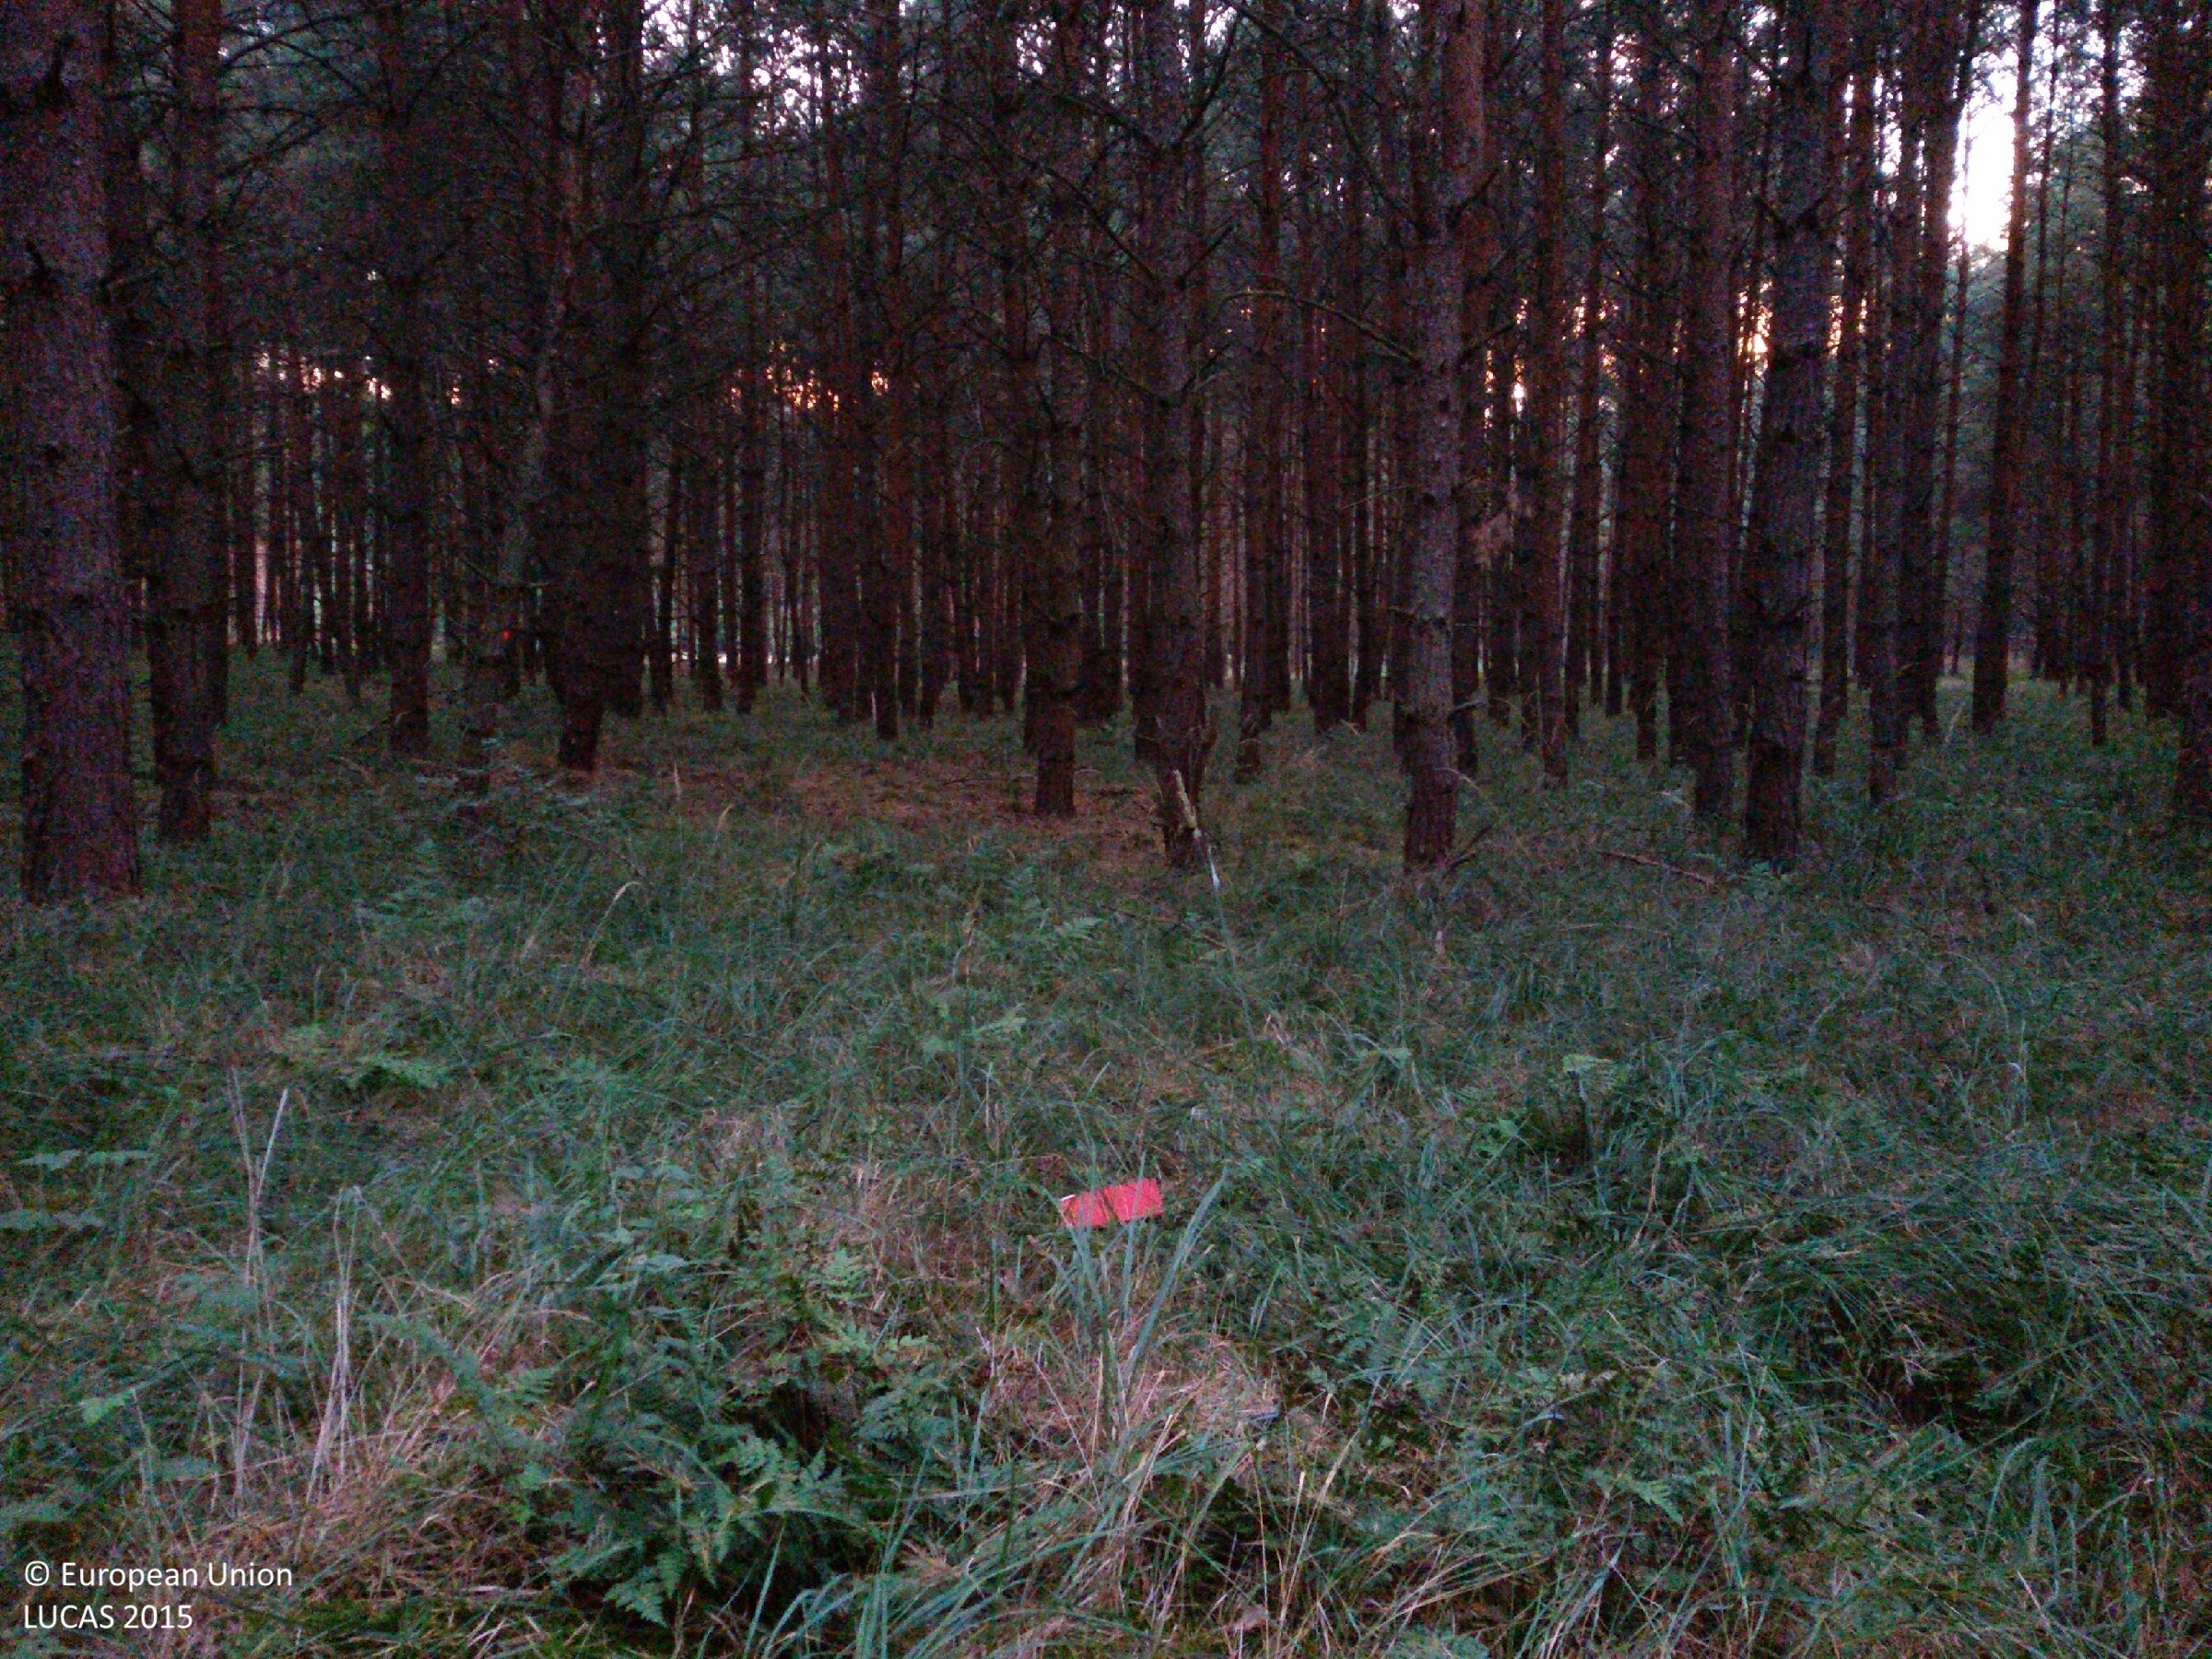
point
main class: Woodland
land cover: Pine dominated coniferous woodland
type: hemiboreal forest and nemoral coniferous forest and mixed broadleaved-coniferous forest
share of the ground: > 75 %
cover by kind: coniferous forest trees 80 %, herbaceous plants 20 %
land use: Forestry
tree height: > 5 m
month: September
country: PL
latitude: 52.3009
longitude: 14.7387
